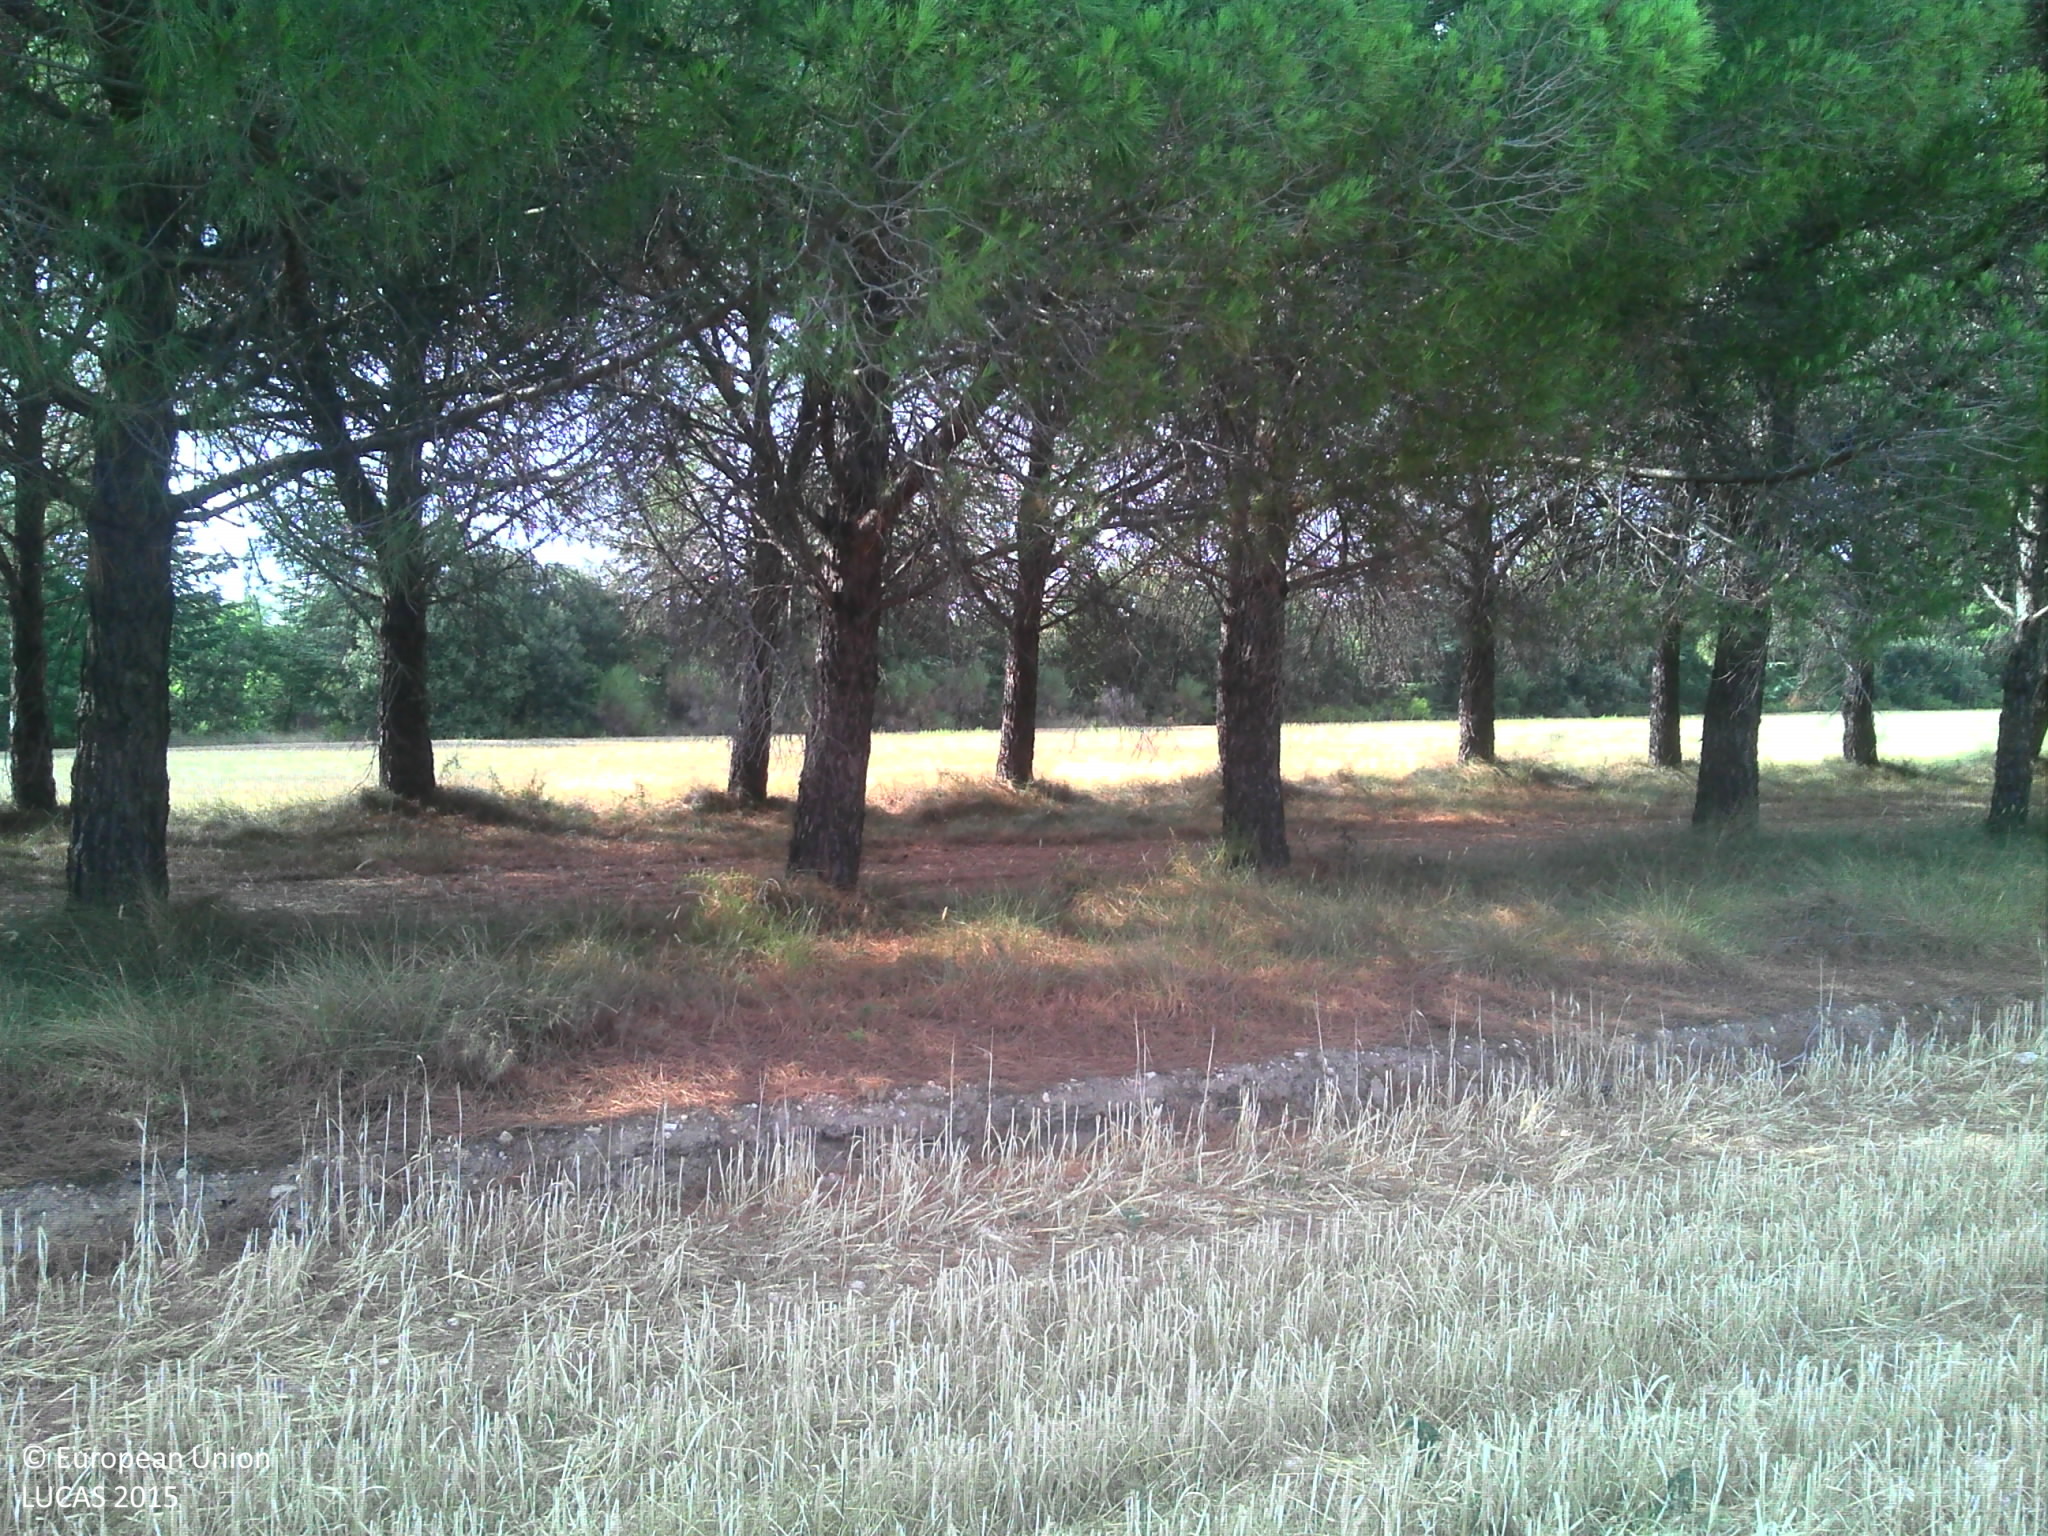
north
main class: Cropland
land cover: Durum wheat
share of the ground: > 75 %
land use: Agriculture (excluding fallow land and kitchen gardens)
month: August
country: FR
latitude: 43.6146
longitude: 5.3629
